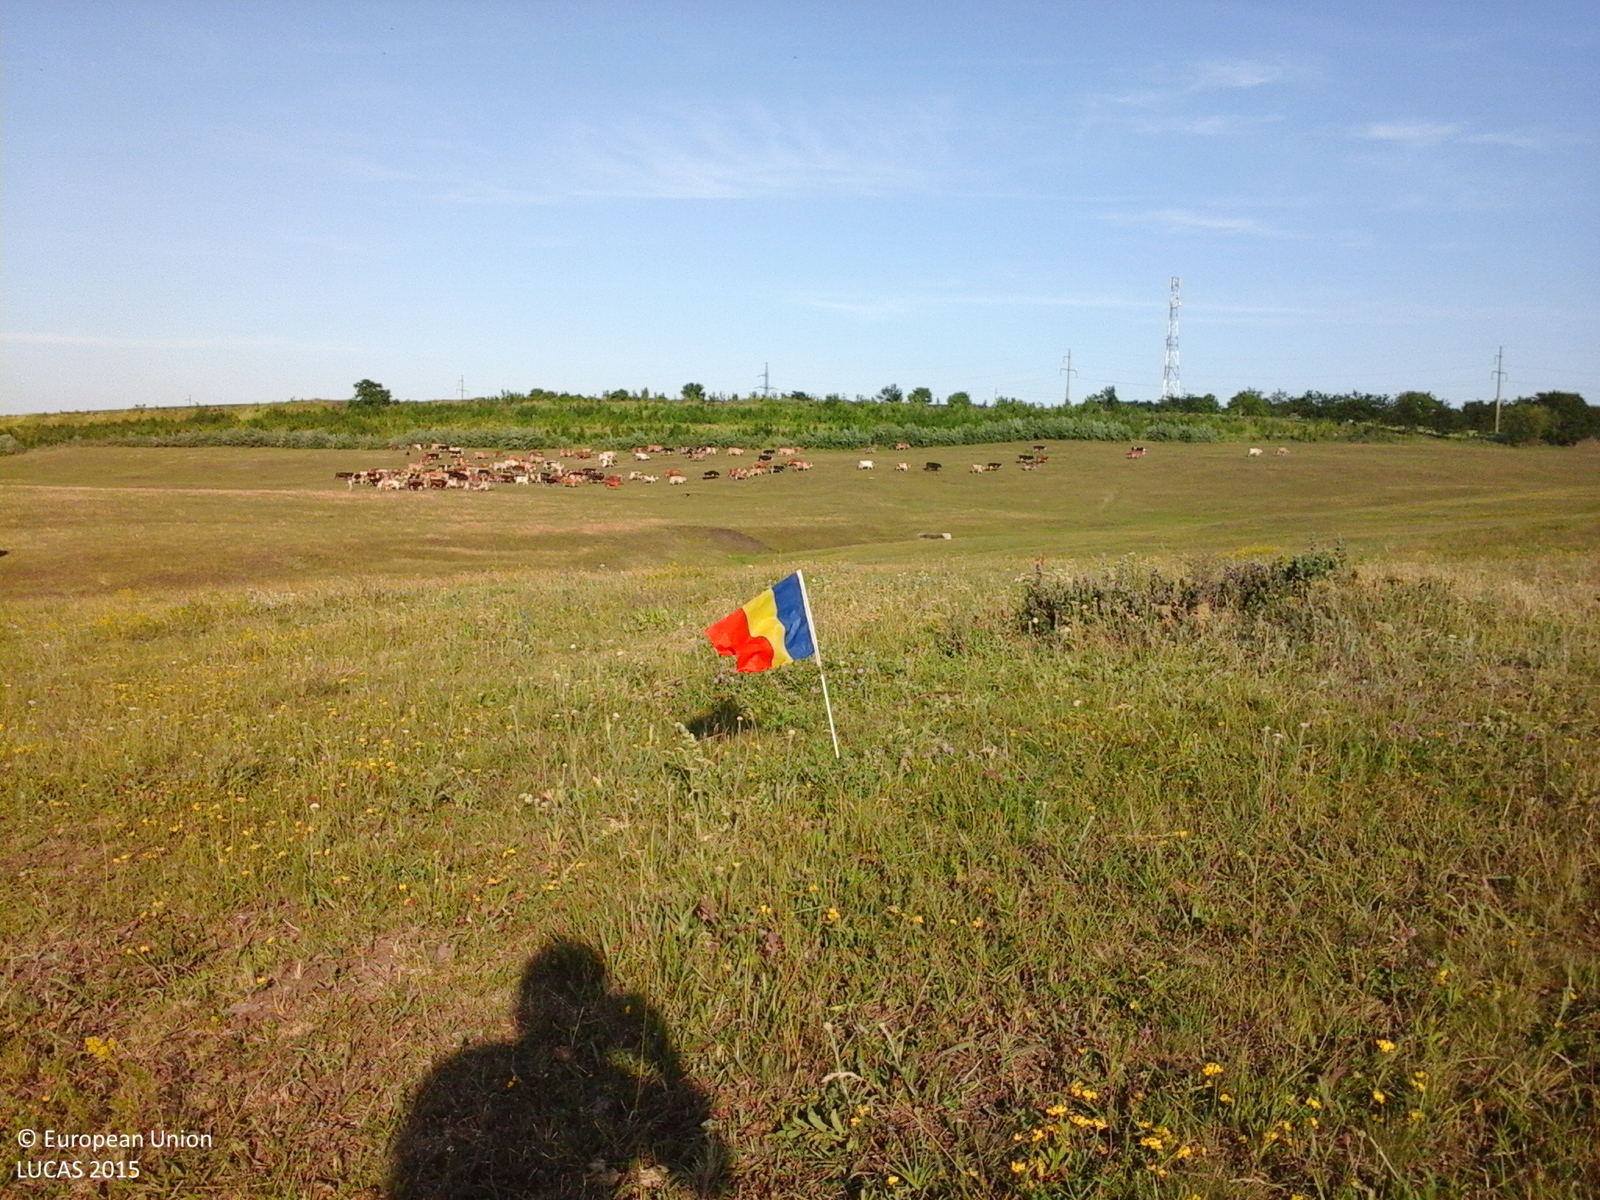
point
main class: Grassland
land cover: Grassland without tree/shrub cover
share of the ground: > 75 %
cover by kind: herbaceous plants 100 %
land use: Agriculture (excluding fallow land and kitchen gardens)
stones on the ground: < 10 %
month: June
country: RO
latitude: 48.0224
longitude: 26.9321
